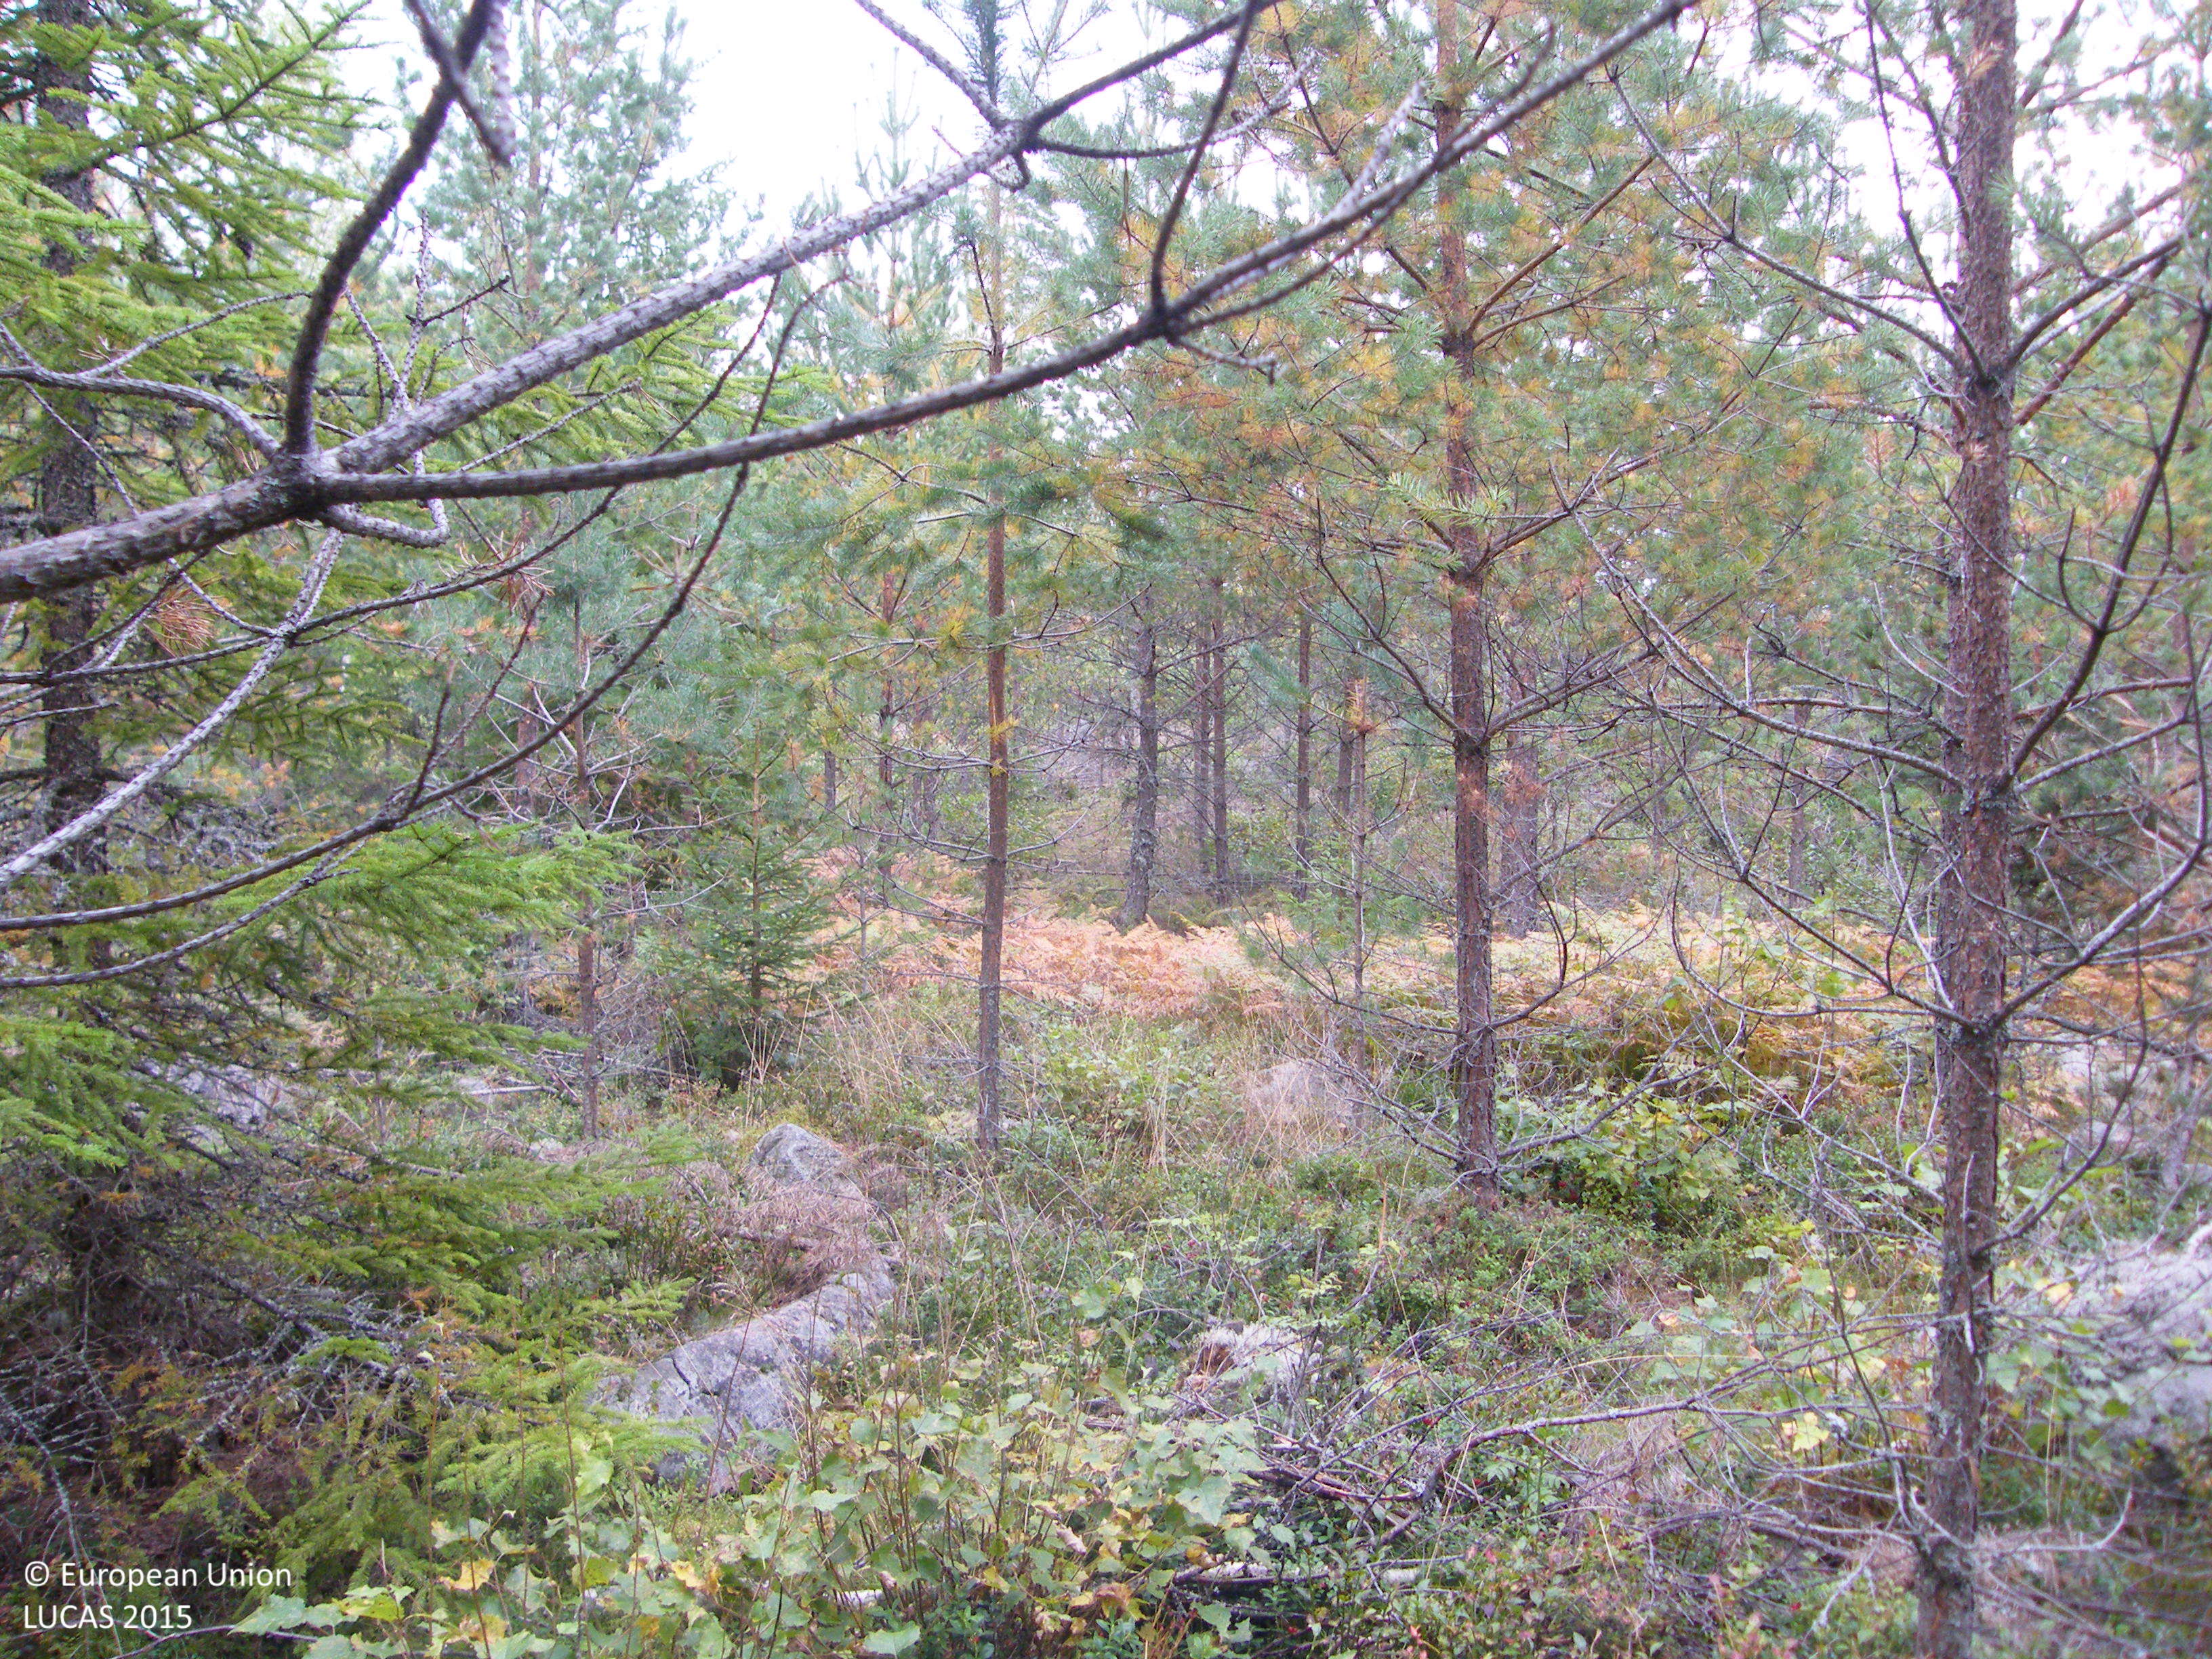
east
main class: Woodland
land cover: Pine dominated coniferous woodland
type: boreal forest
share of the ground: 50 - 75 %
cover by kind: coniferous forest trees 65 %, shrubs 20 %, lichens and mosses 10 %, broadleaved forest trees 5 %
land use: Forestry
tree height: > 5 m
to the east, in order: Pine dominated coniferous woodland; Other mixed woodland; Ditches and canals; Groves; Paved roads, cycling and walking lanes; Pine dominated mixed woodland; Other mixed woodland; Tracks; Other mixed woodland
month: September
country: SE
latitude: 59.5655
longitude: 15.5660
